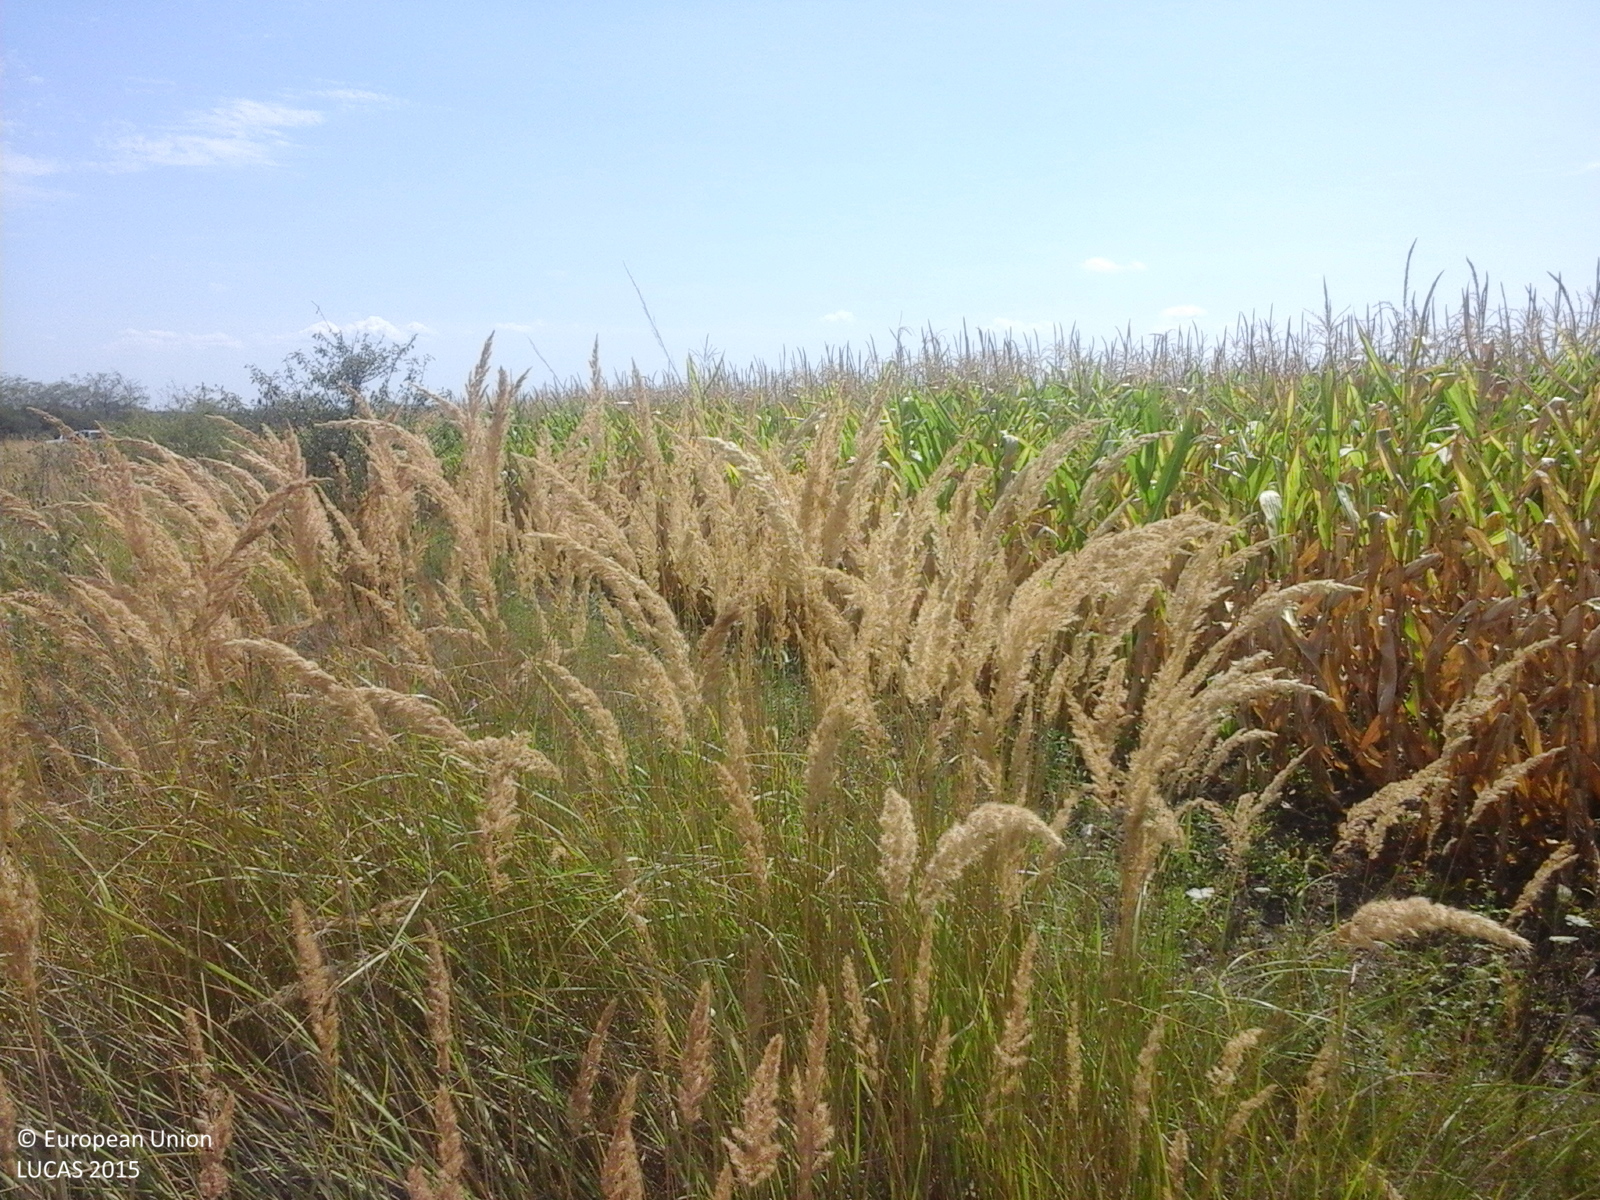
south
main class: Grassland
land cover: Grassland with sparse tree/shrub cover
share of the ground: > 75 %
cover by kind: herbaceous plants 85 %, shrubs 10 %, broadleaved forest trees 5 %
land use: Fallow land
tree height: < 5 m
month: August
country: RO
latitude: 45.3572
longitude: 21.4043
